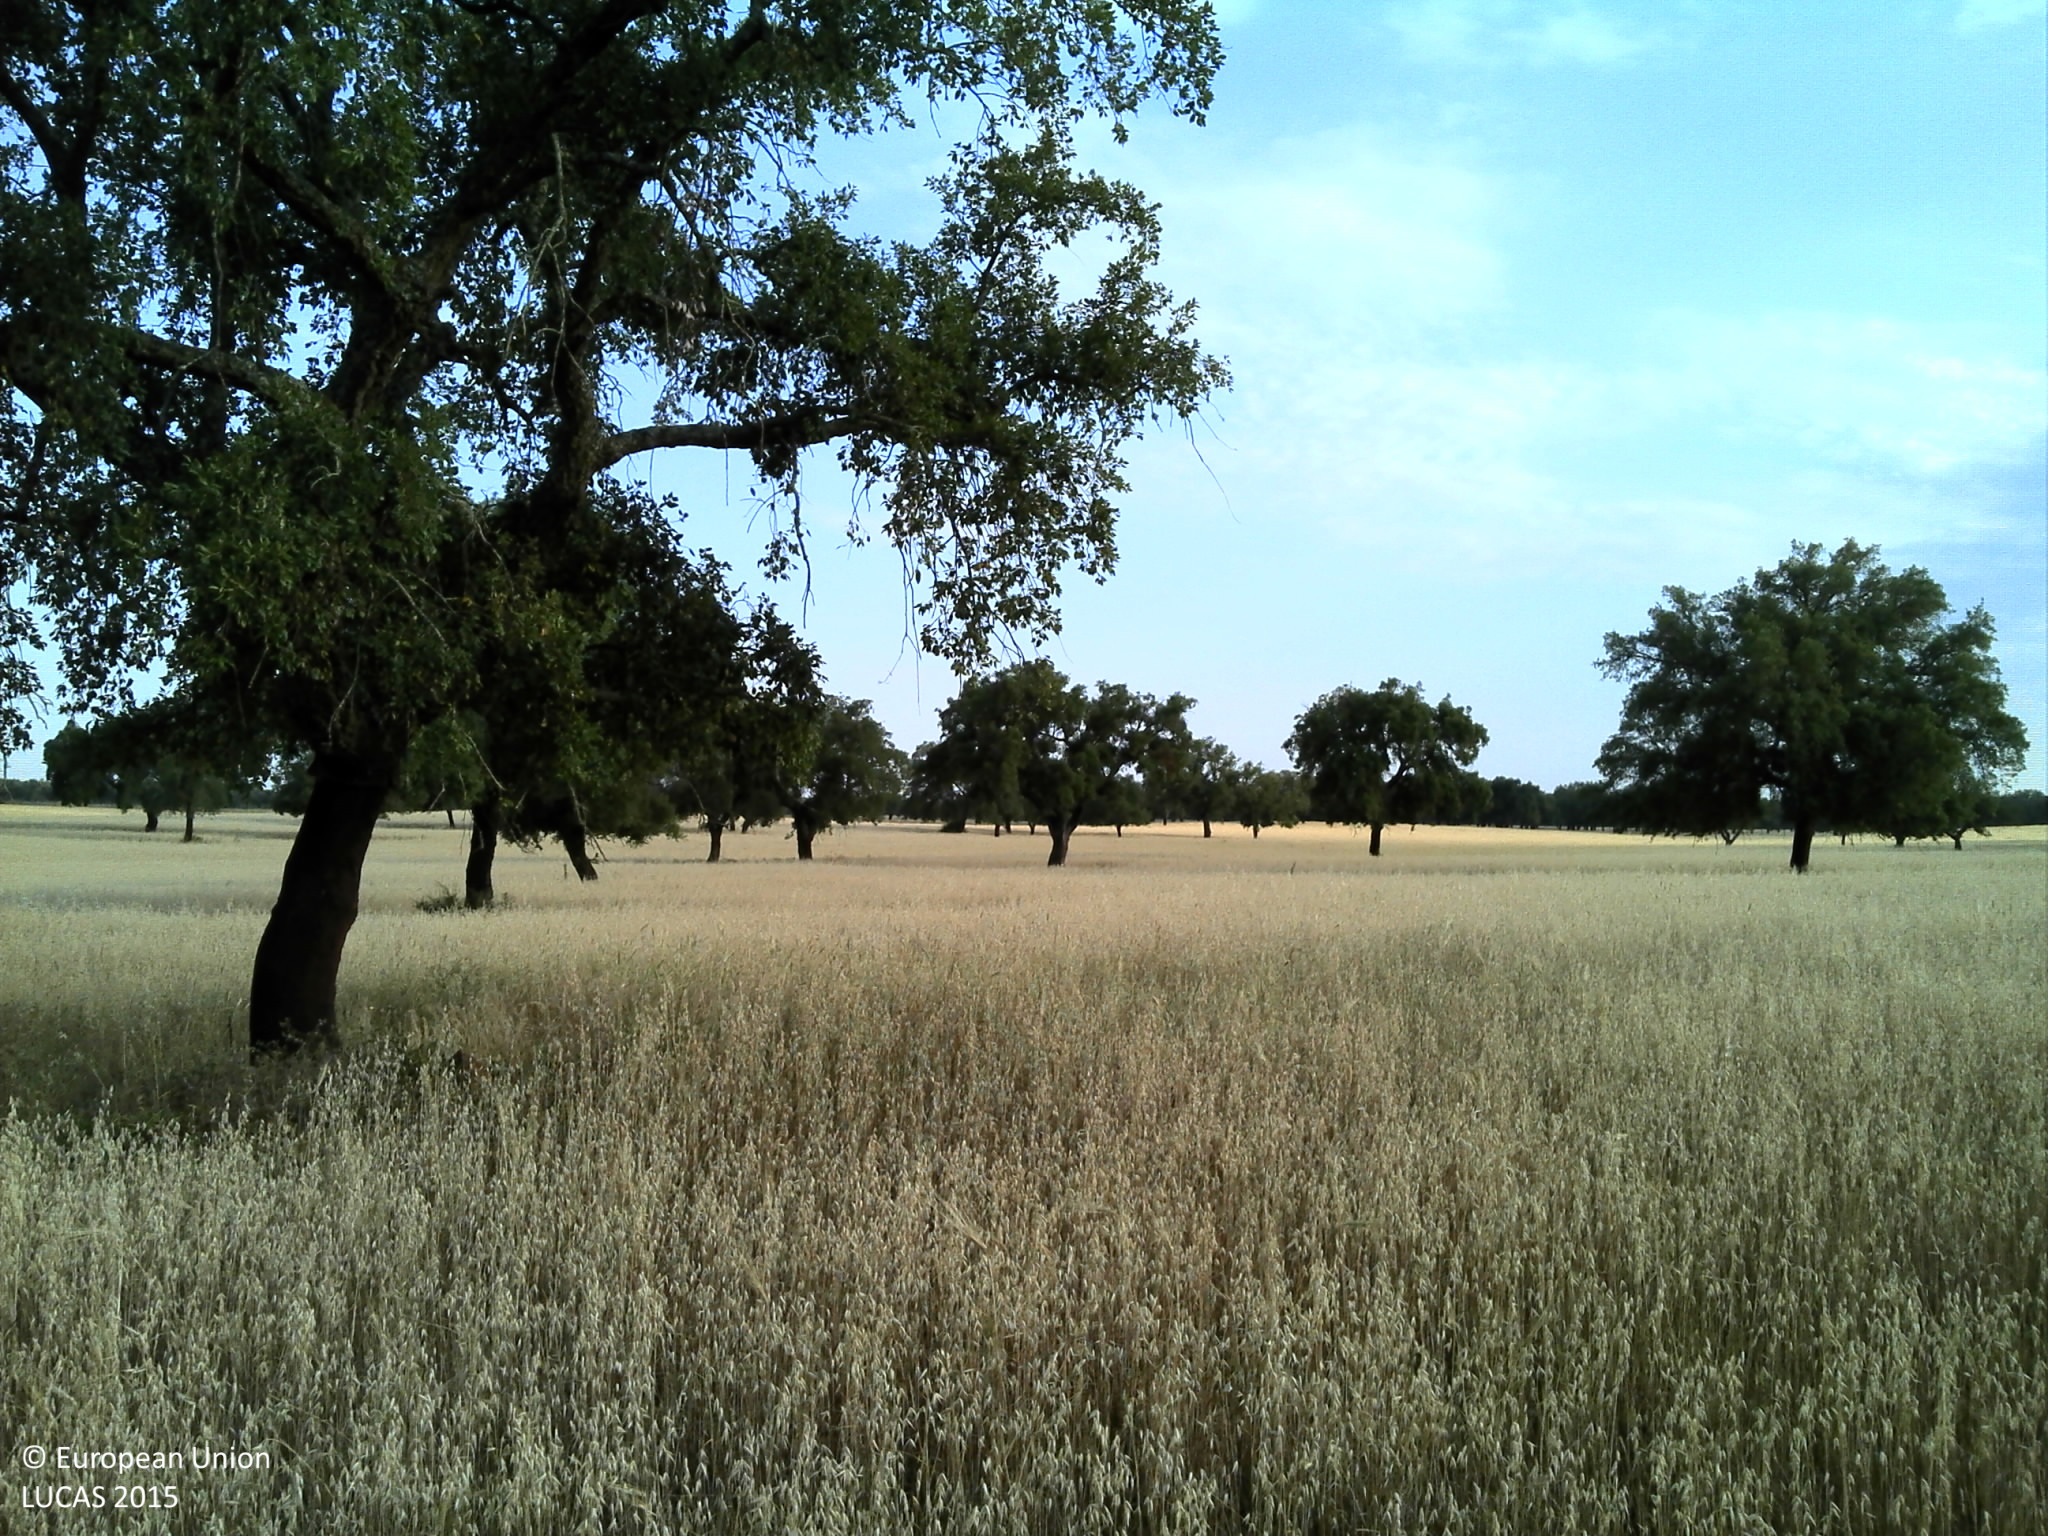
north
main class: Woodland
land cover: Broadleaved woodland
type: broadleaved evergreen forest
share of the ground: 25 - 50 %
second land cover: Oats
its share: > 75 %
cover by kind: herbaceous plants 60 %, broadleaved forest trees 30 %, unconsolidated bare surface 10 %
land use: Forestry
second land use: Agriculture (excluding fallow land and kitchen gardens)
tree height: > 5 m
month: May
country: PT
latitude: 38.9433
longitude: -7.7764
